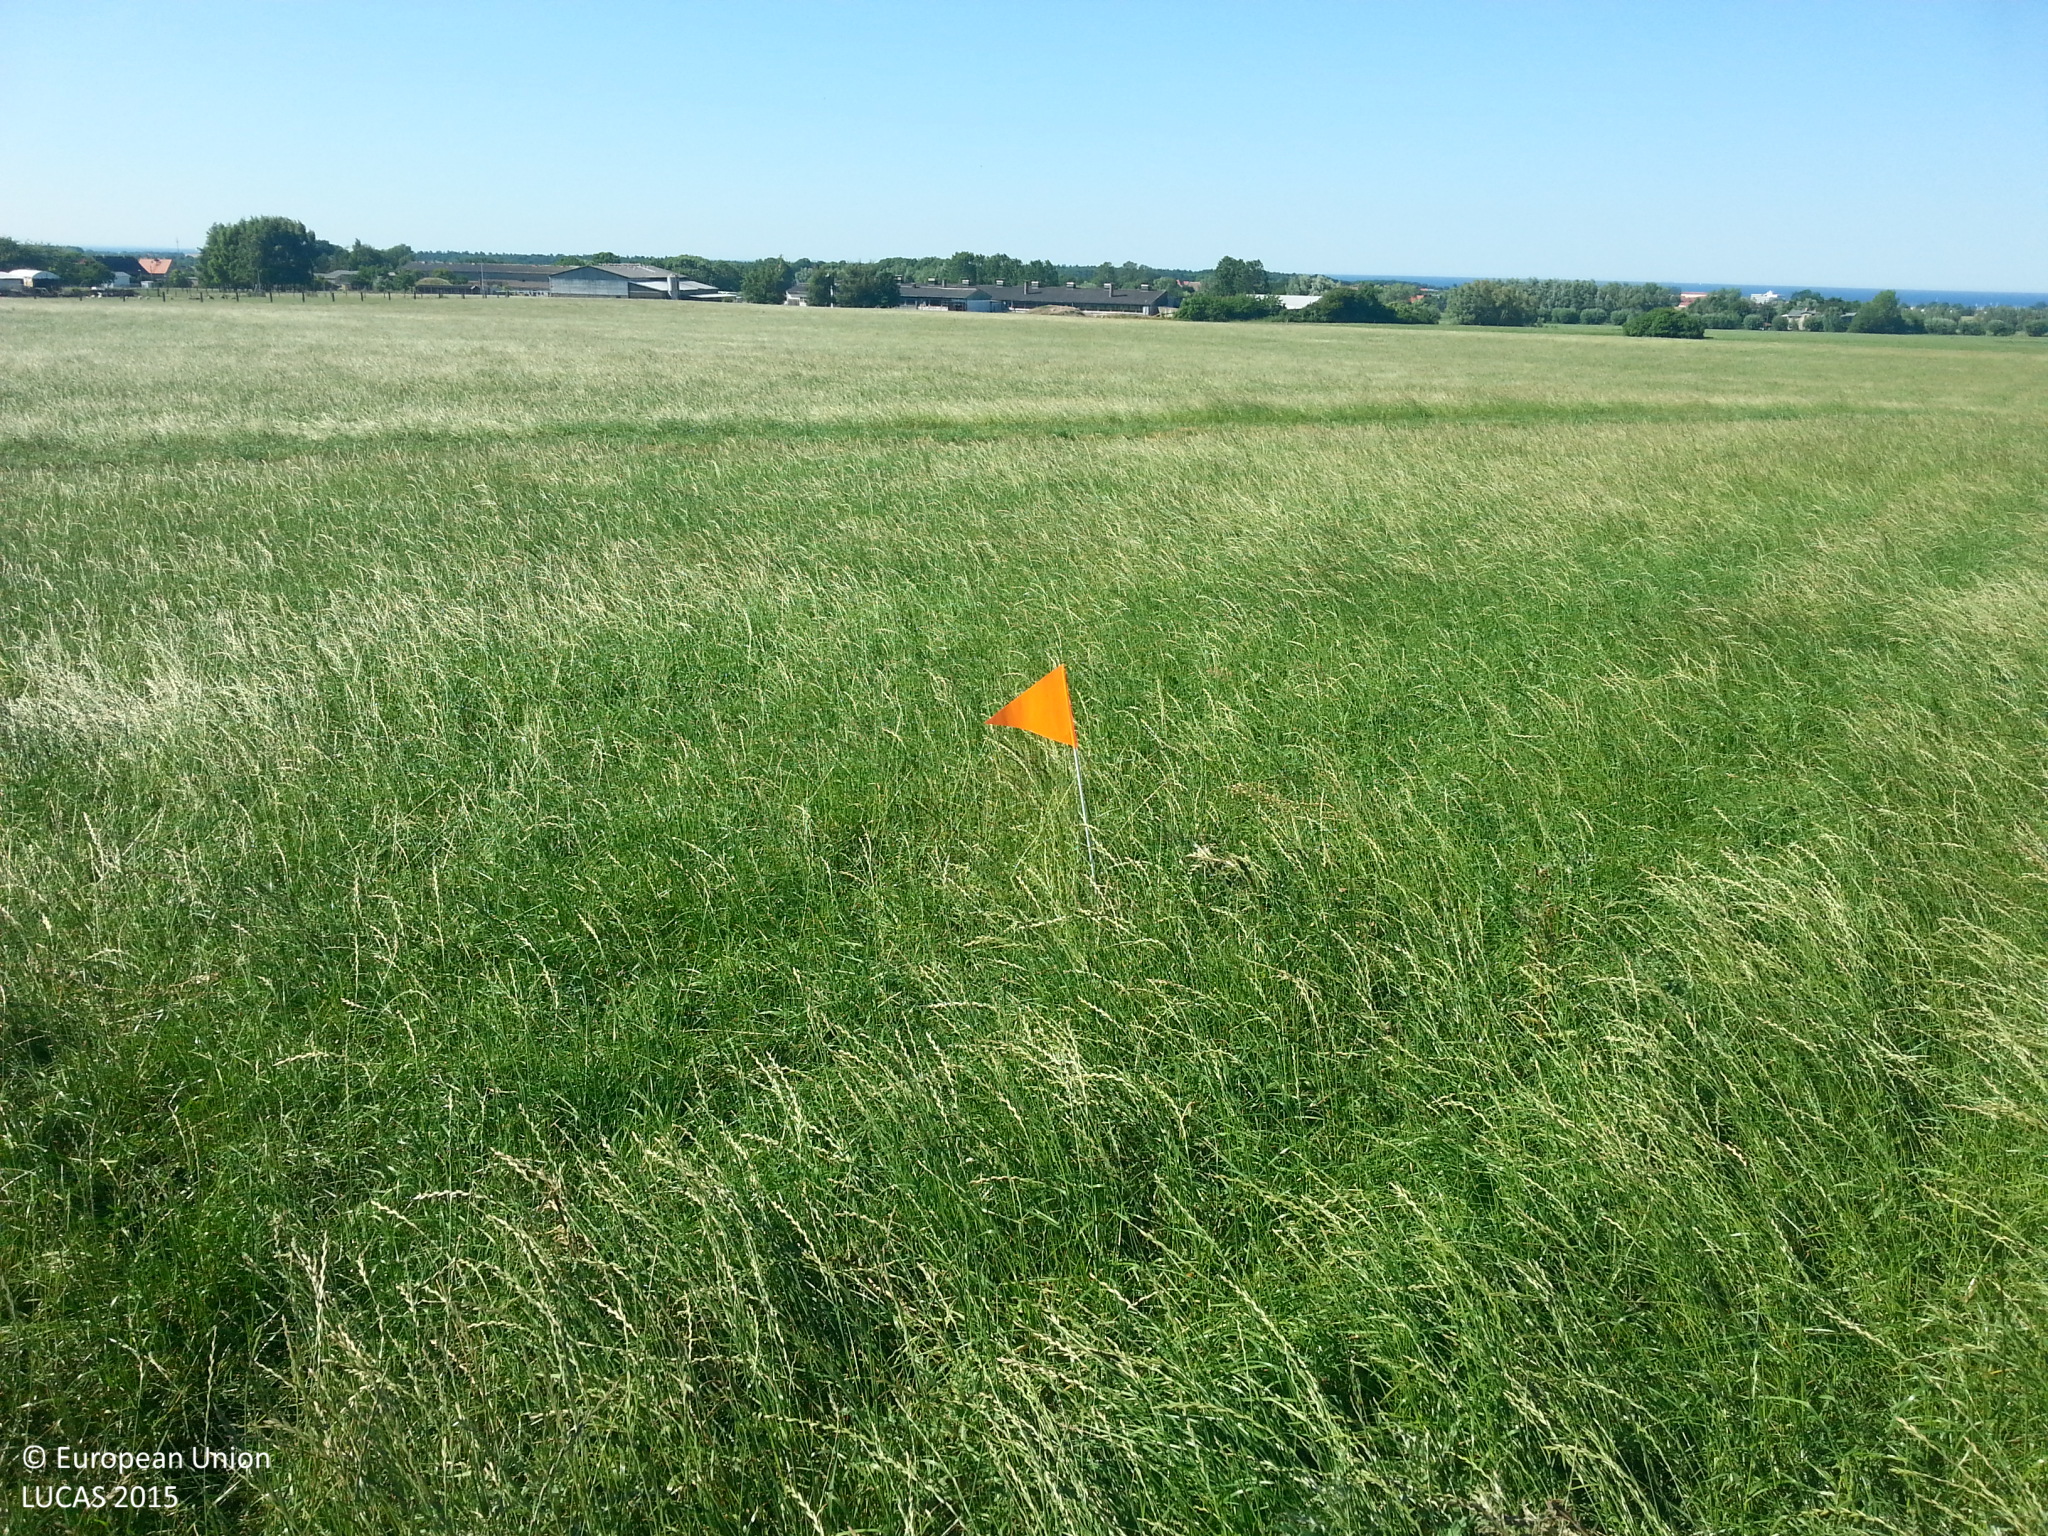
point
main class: Grassland
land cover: Grassland without tree/shrub cover
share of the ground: > 75 %
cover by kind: herbaceous plants 100 %
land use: Agriculture (excluding fallow land and kitchen gardens)
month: July
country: DE
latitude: 54.1262
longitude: 11.7589
